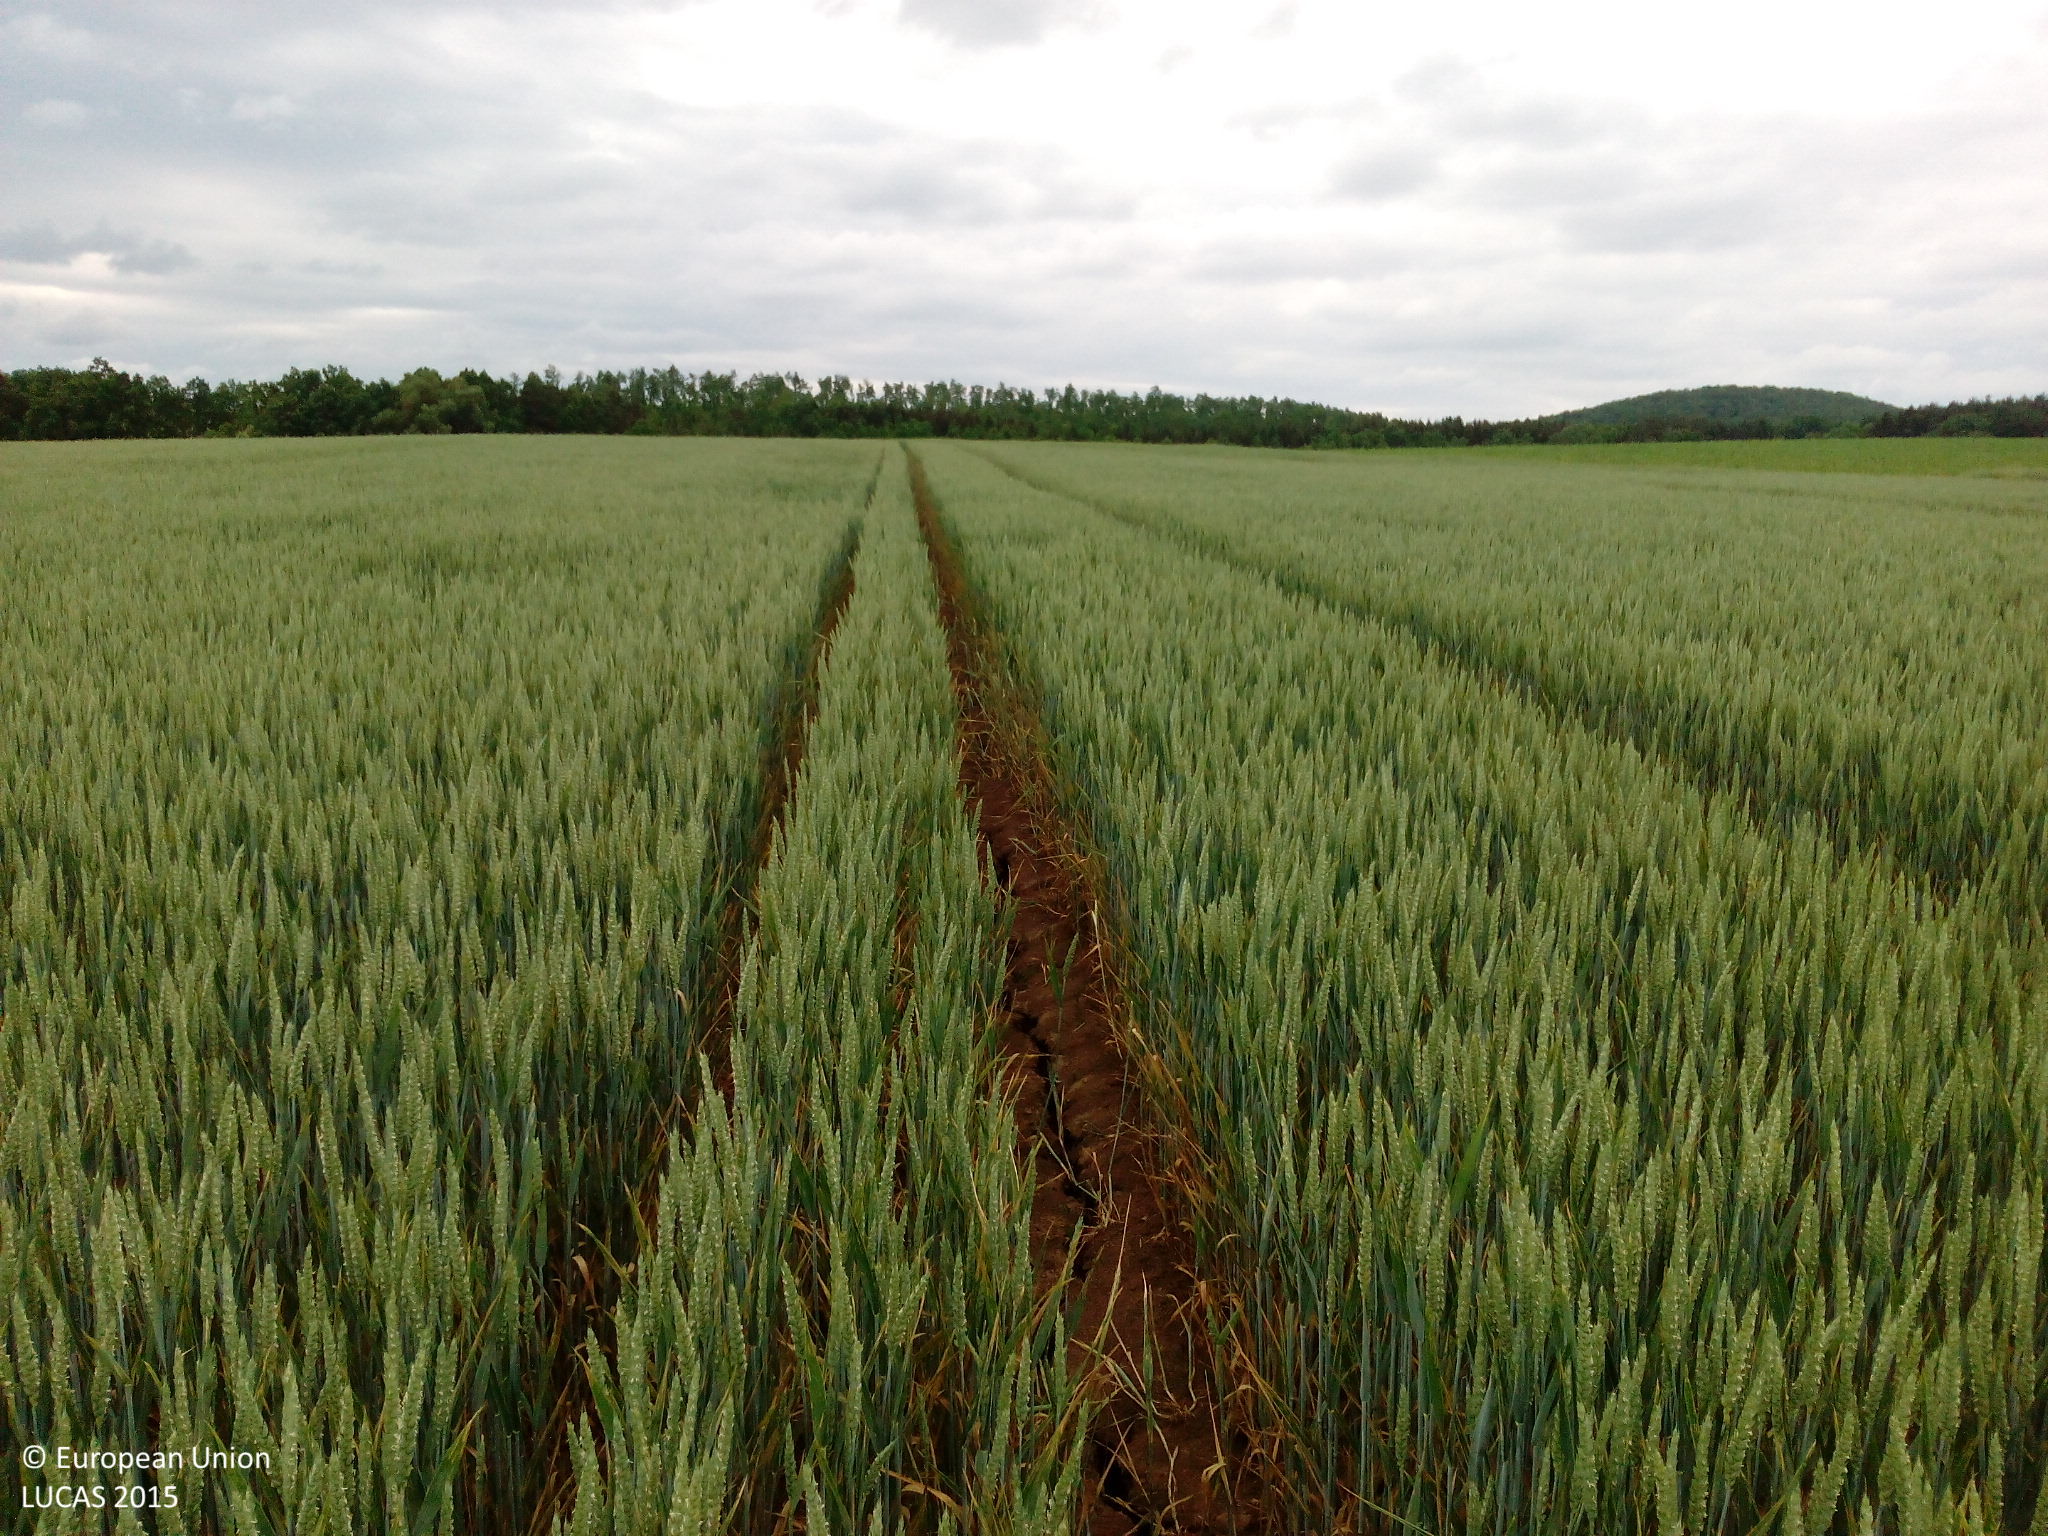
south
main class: Cropland
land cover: Common wheat
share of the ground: > 75 %
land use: Agriculture (excluding fallow land and kitchen gardens)
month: June
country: DE
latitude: 50.2556
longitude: 10.3505
